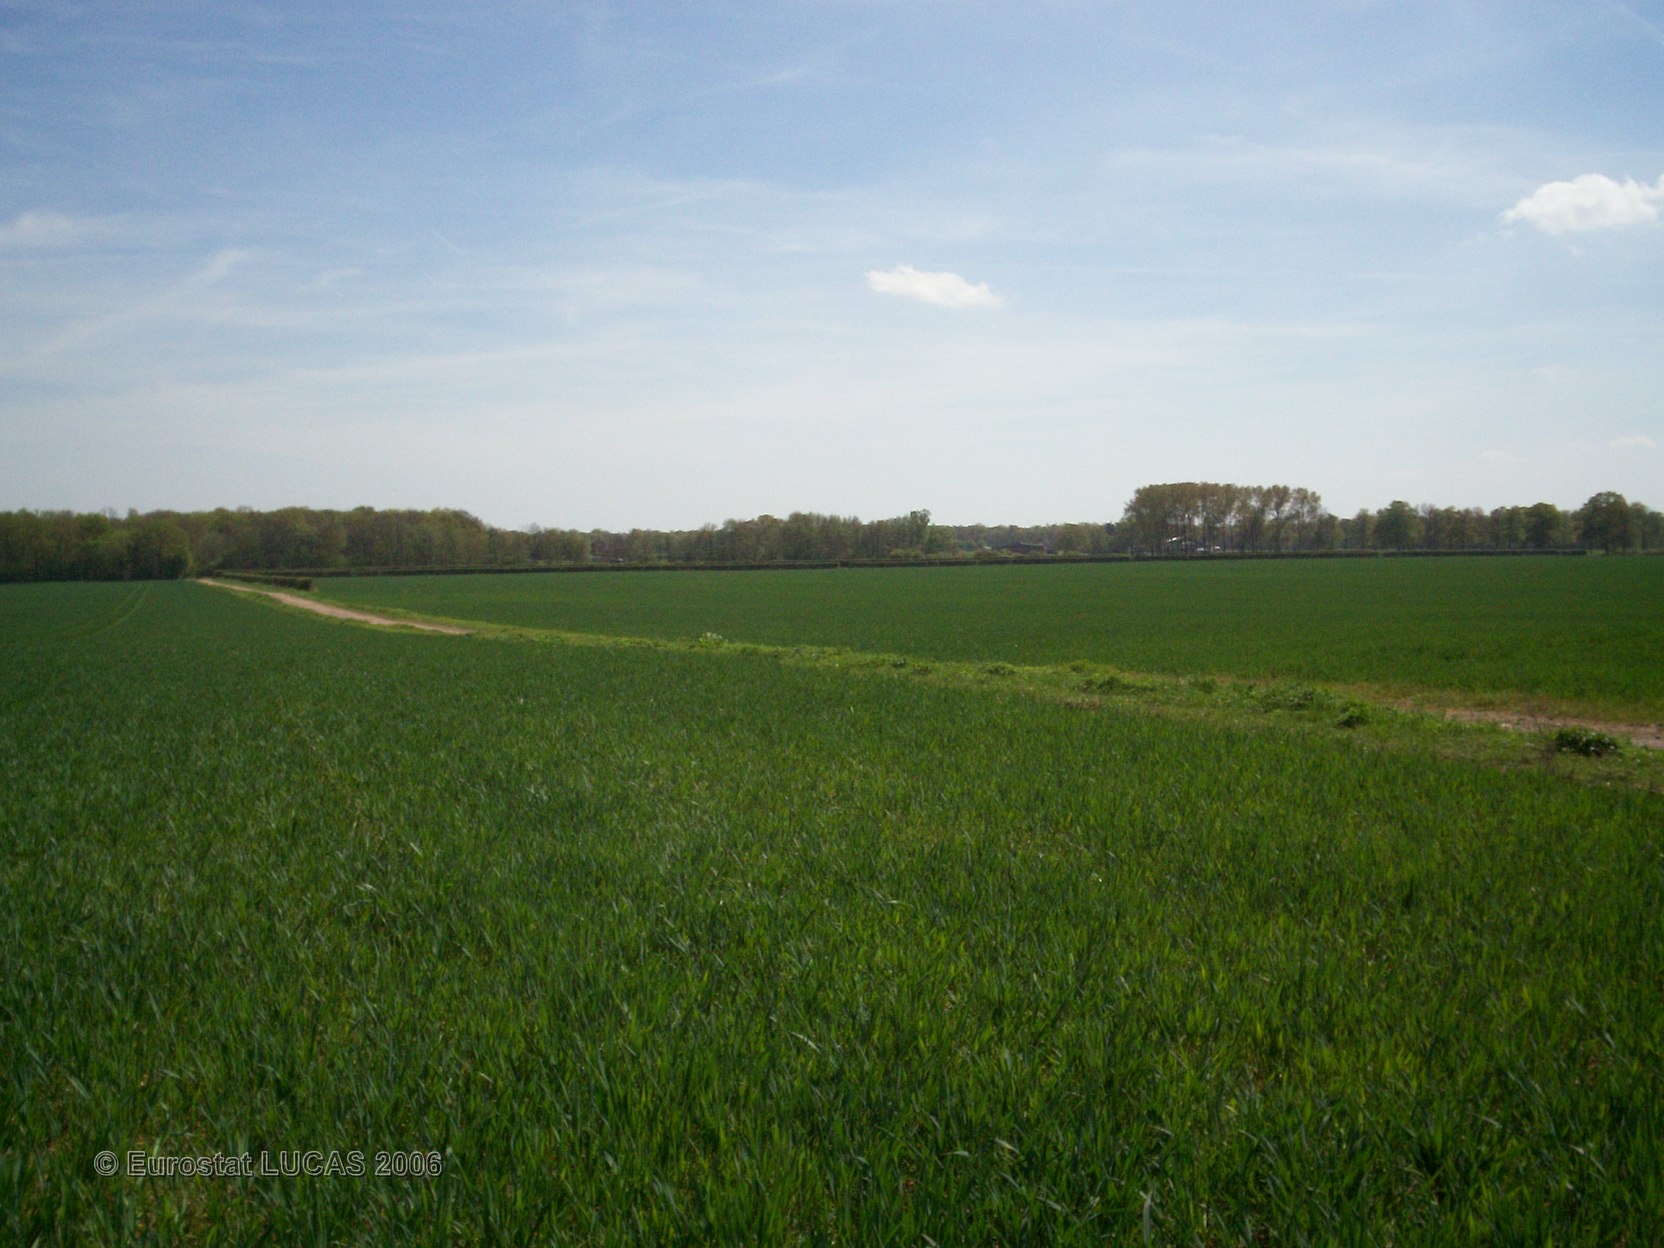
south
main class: Cropland
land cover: Common wheat
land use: Agriculture (excluding fallow land and kitchen gardens)
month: May
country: FR
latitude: 48.8001
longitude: 2.7884
